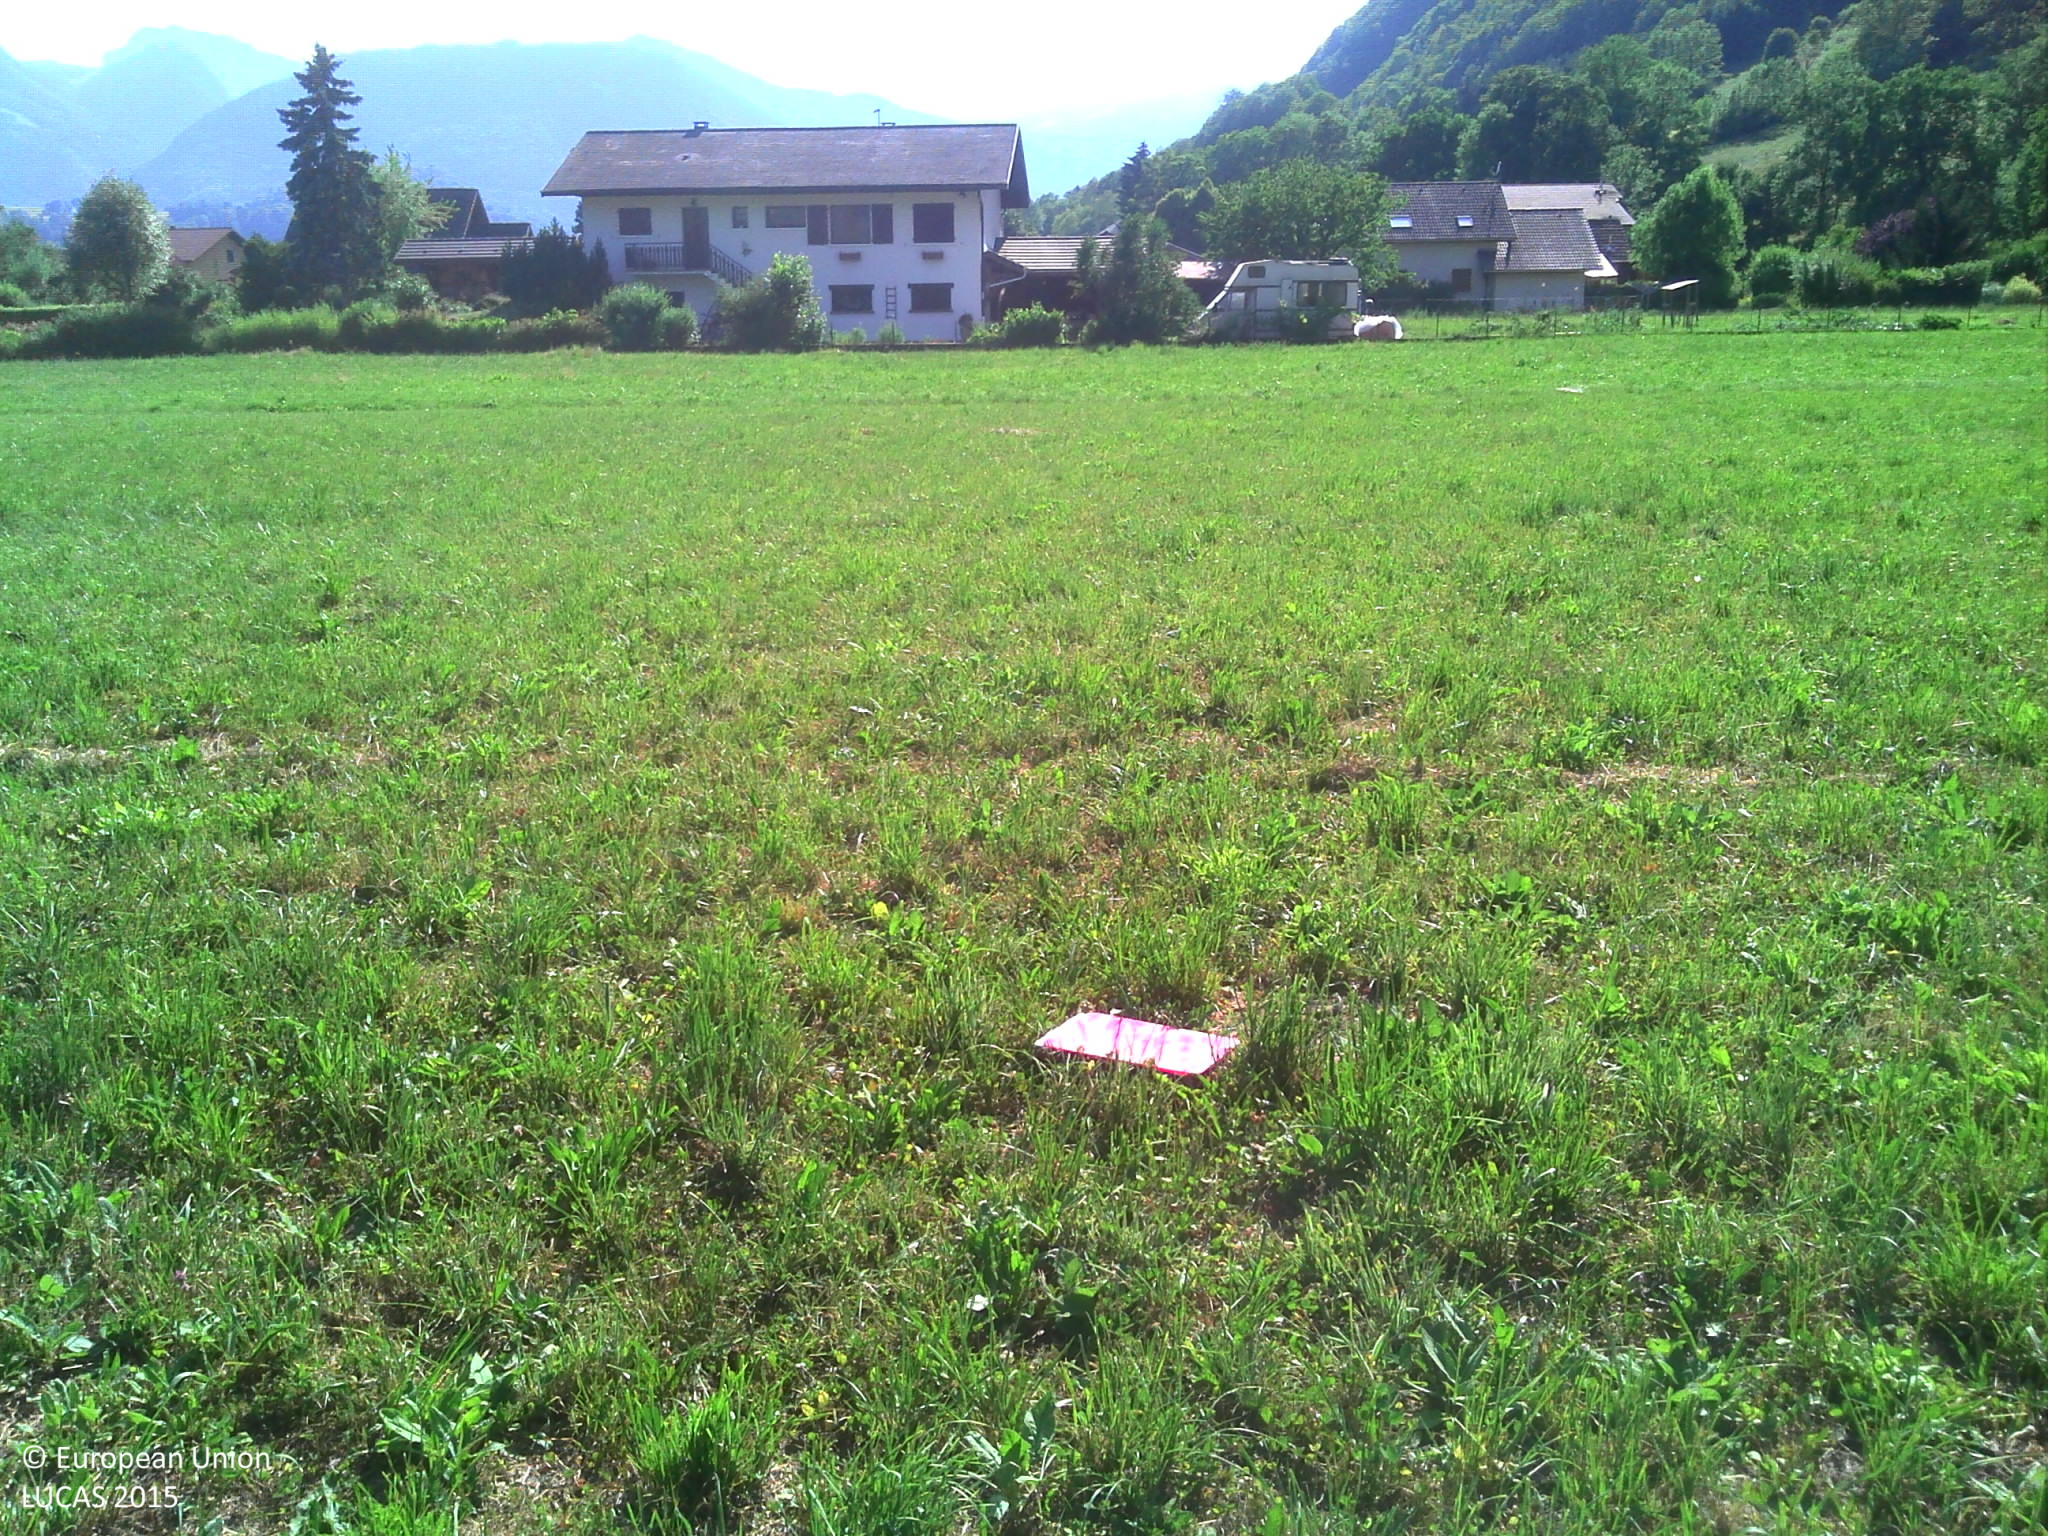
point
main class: Grassland
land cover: Grassland without tree/shrub cover
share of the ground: > 75 %
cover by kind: herbaceous plants 100 %
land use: Agriculture (excluding fallow land and kitchen gardens)
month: July
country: FR
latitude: 45.7657
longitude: 6.3396
